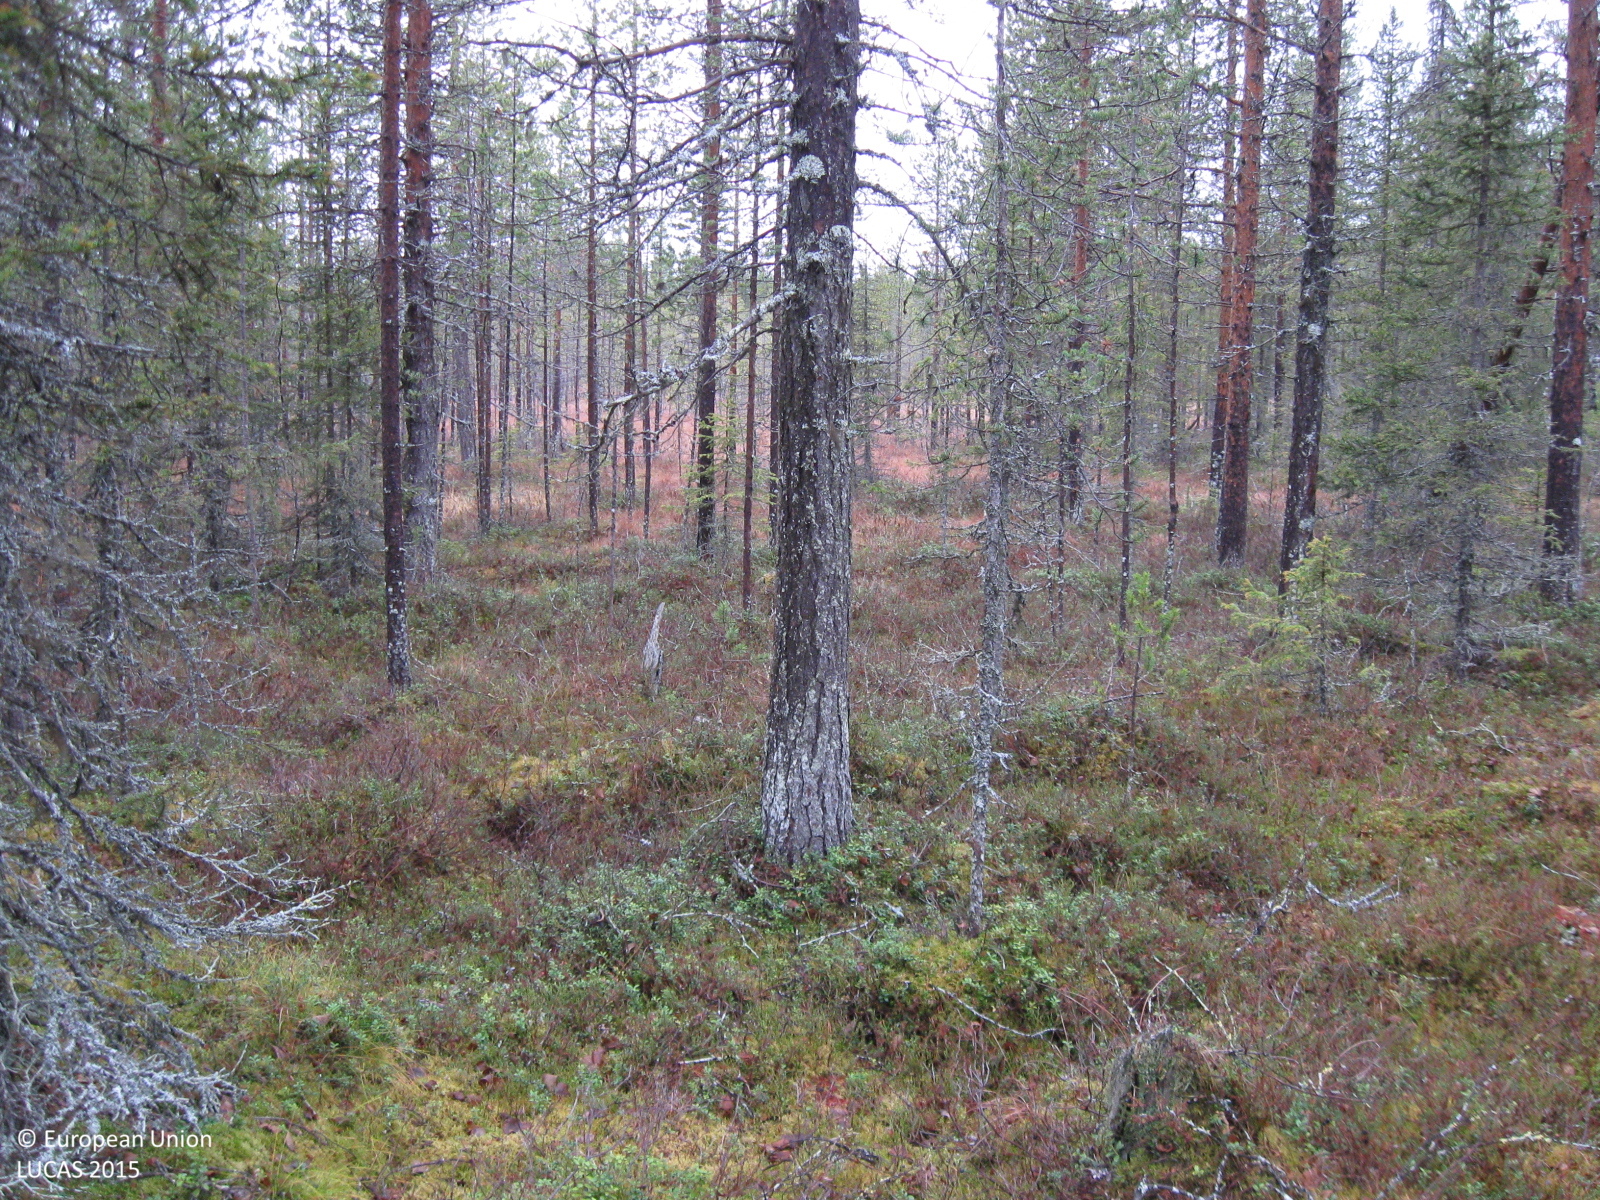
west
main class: Woodland
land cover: Other coniferous woodland
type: boreal forest
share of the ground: > 75 %
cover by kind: coniferous forest trees 70 %, broadleaved forest trees 10 %, shrubs 10 %, herbaceous plants 5 %, lichens and mosses 5 %
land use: Forestry
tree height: > 5 m
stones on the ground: 10 - 25 %
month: October
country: SE
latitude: 66.6926
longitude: 21.7167
